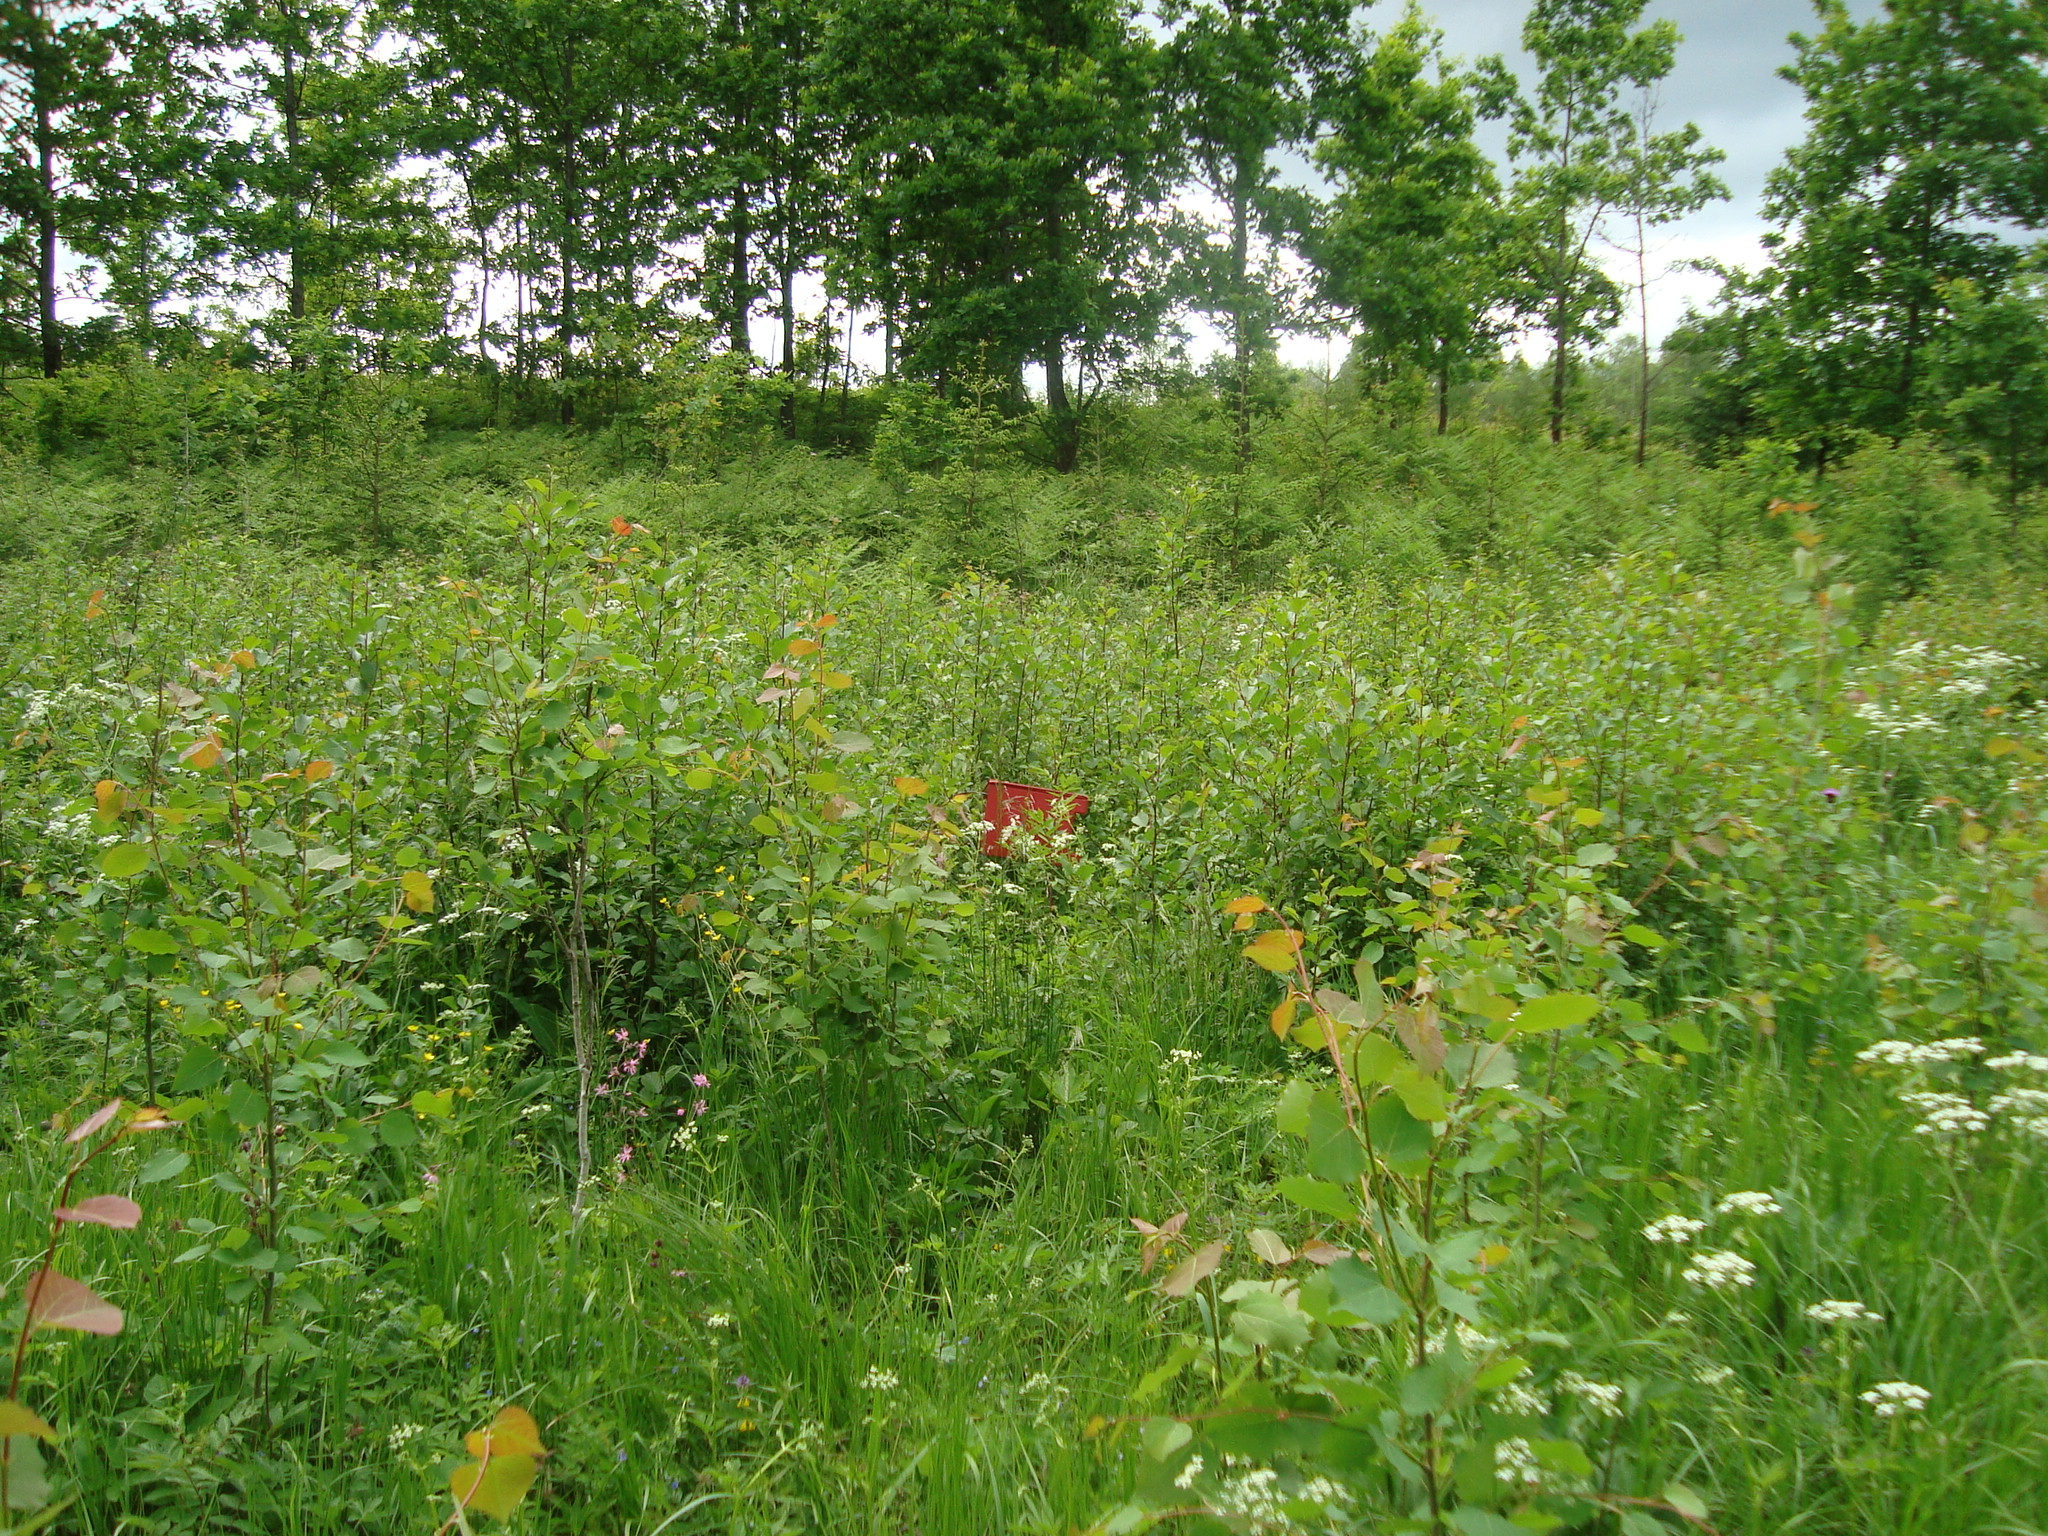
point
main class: Shrubland
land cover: Shrubland with sparse tree cover
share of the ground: 50 - 75 %
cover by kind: shrubs 70 %, herbaceous plants 25 %, broadleaved forest trees 5 %
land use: Forestry
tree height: < 5 m
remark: Clear cut
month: June
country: LV
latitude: 56.9983
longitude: 25.8143
